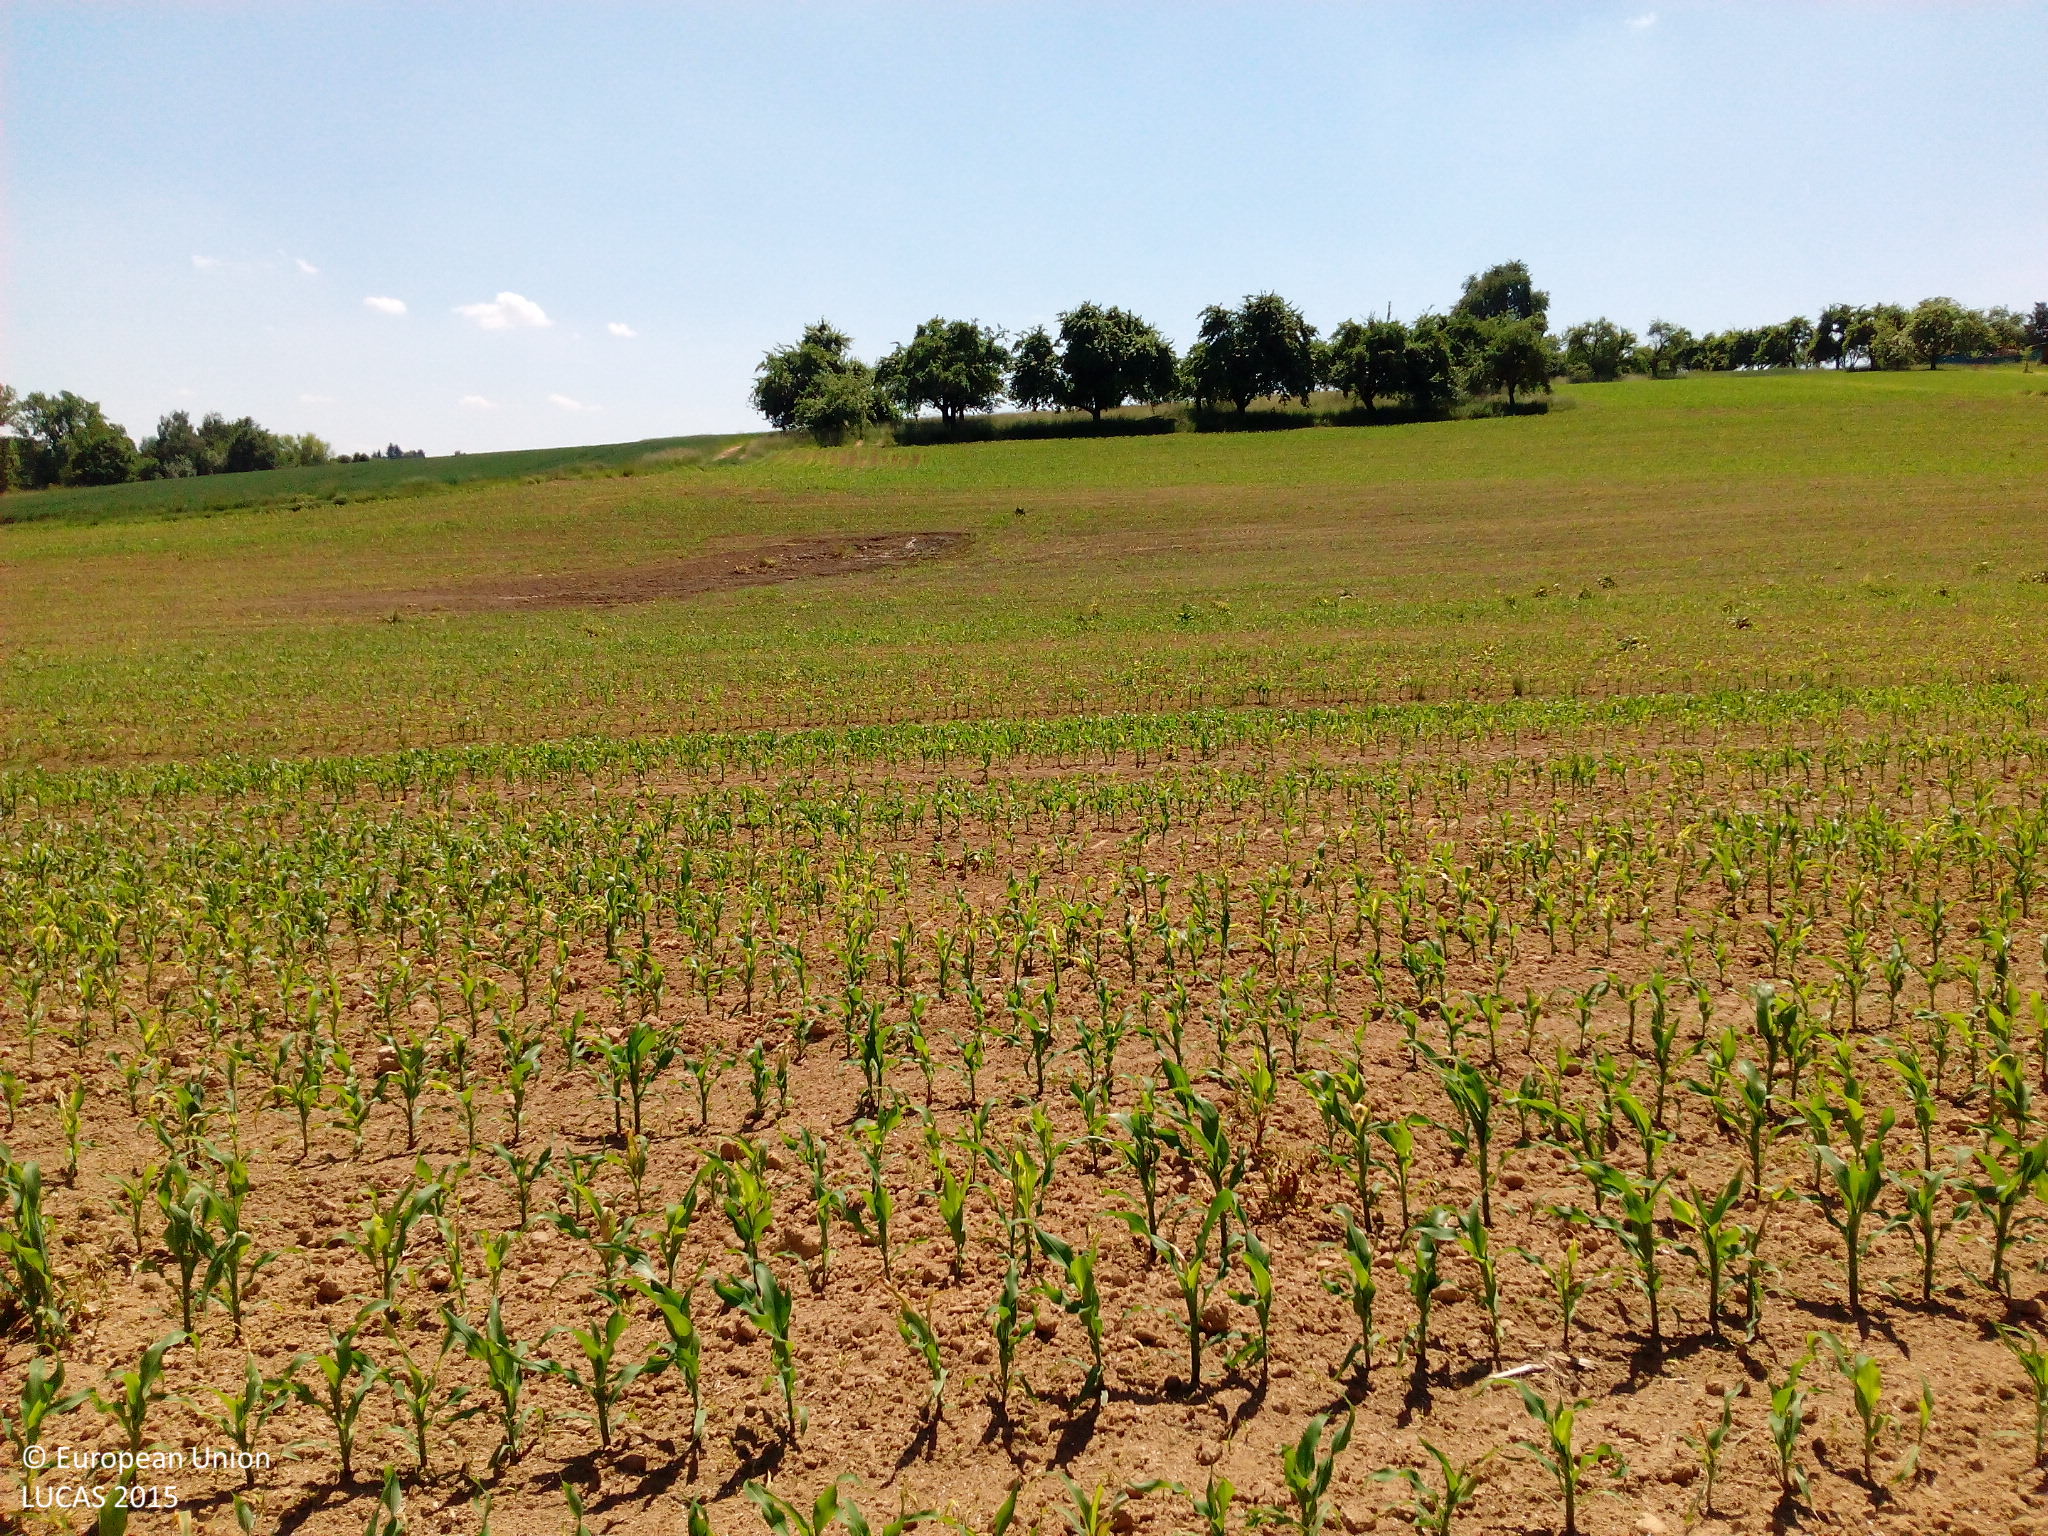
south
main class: Cropland
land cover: Maize
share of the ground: 10 - 25 %
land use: Agriculture (excluding fallow land and kitchen gardens)
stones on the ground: < 10 %
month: June
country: DE
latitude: 48.9597
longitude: 9.4130
